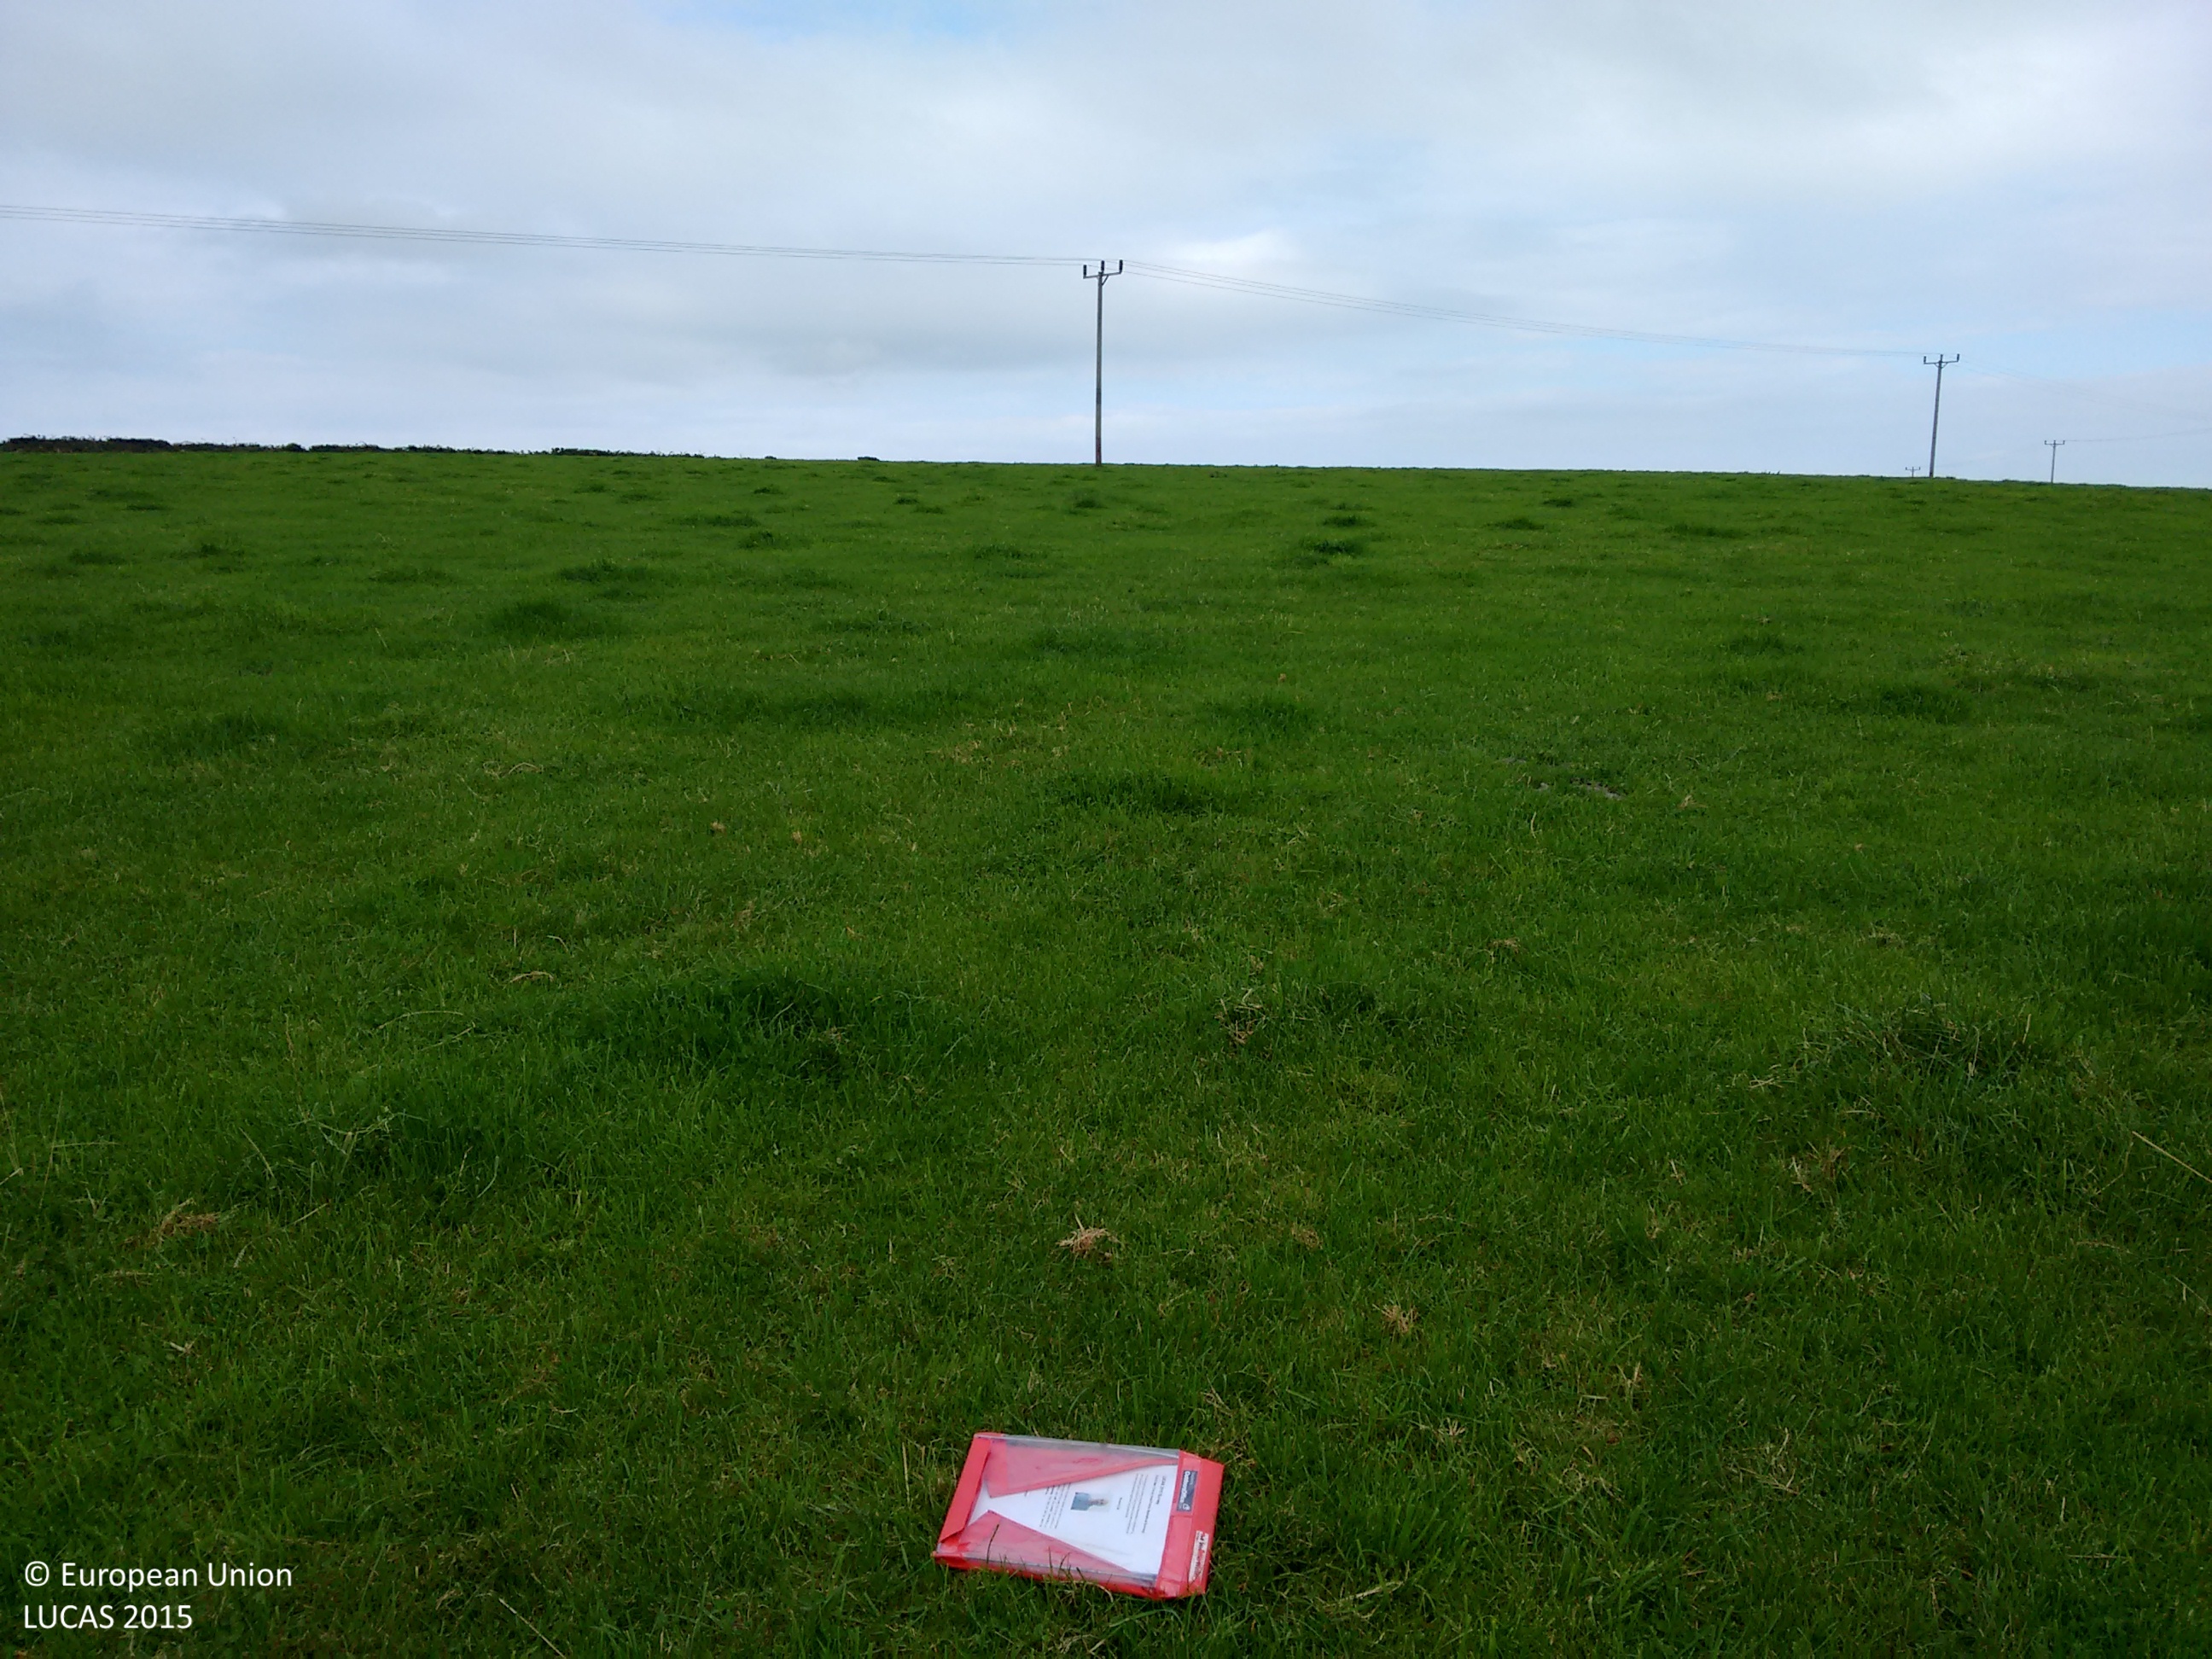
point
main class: Grassland
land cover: Grassland without tree/shrub cover
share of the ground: > 75 %
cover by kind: herbaceous plants 100 %
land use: Agriculture (excluding fallow land and kitchen gardens)
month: September
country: GB
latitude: 52.0969
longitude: -4.5433
